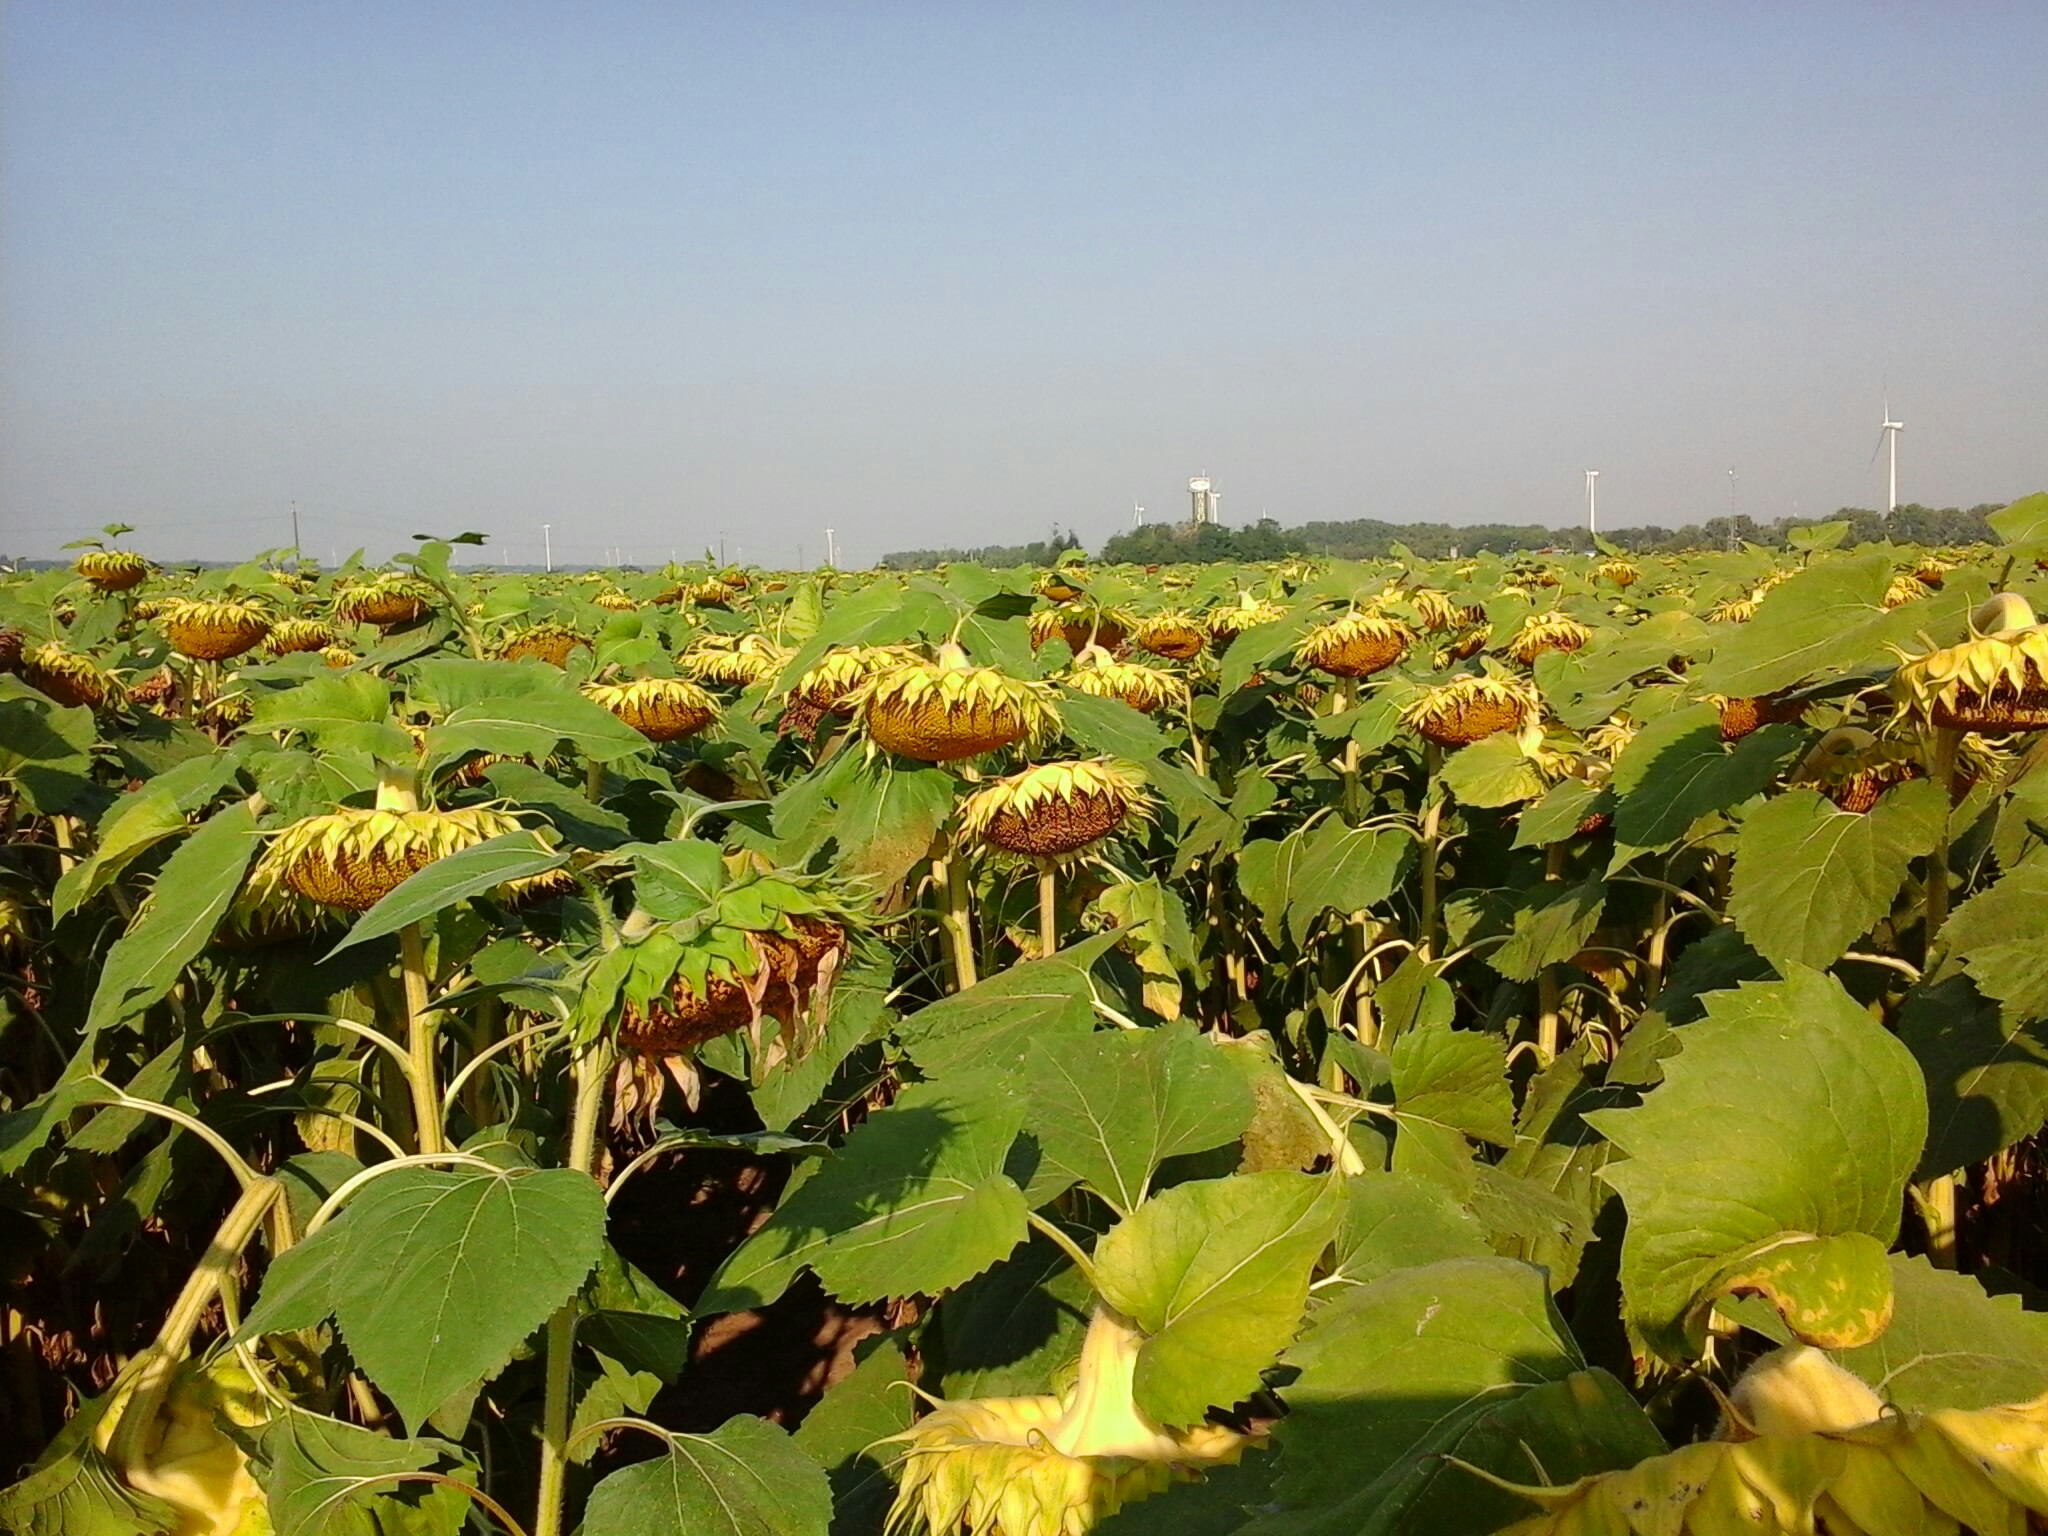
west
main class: Cropland
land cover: Sunflower
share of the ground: > 75 %
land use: Agriculture (excluding fallow land and kitchen gardens)
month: August
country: HU
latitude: 47.6801
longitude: 17.9903
